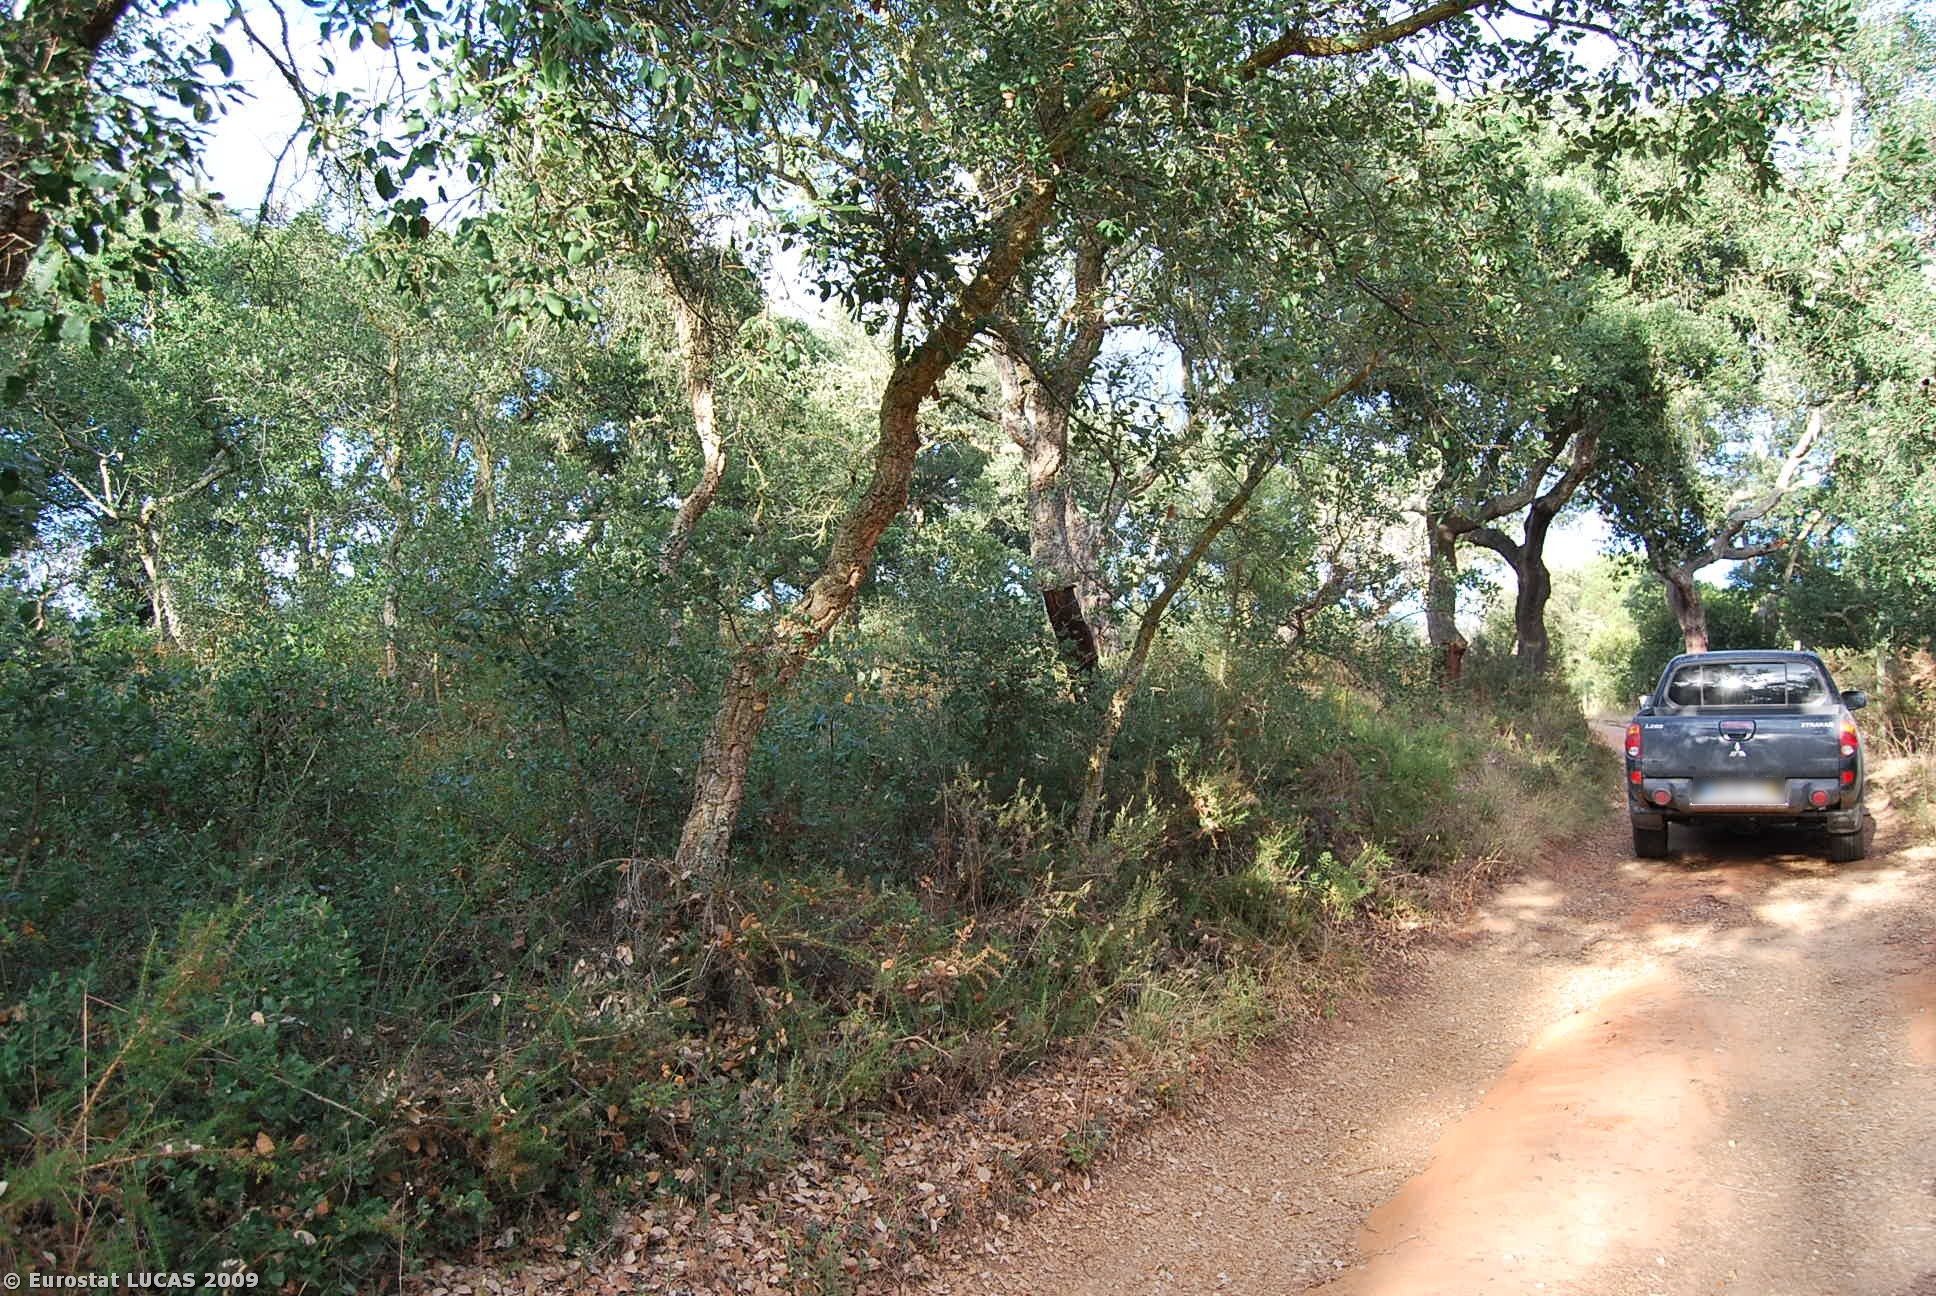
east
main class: Woodland
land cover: Broadleaved woodland
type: broadleaved evergreen forest
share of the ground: 25 - 50 %
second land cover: Spontaneously vegetated surfaces
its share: 50 - 75 %
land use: Forestry
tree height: > 5 m
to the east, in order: Broadleaved woodland; Spontaneously vegetated surfaces; Electric lines; Fences; Tracks; Lines of trees; Arable land (only in case pi); Shrubland with sparse tree cover; Permanent crops (only in case pi); Tracks; Permanent crops (only in case pi); Tracks; Arable land (only in case pi)
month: June
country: PT
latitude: 38.0213
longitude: -8.7194
